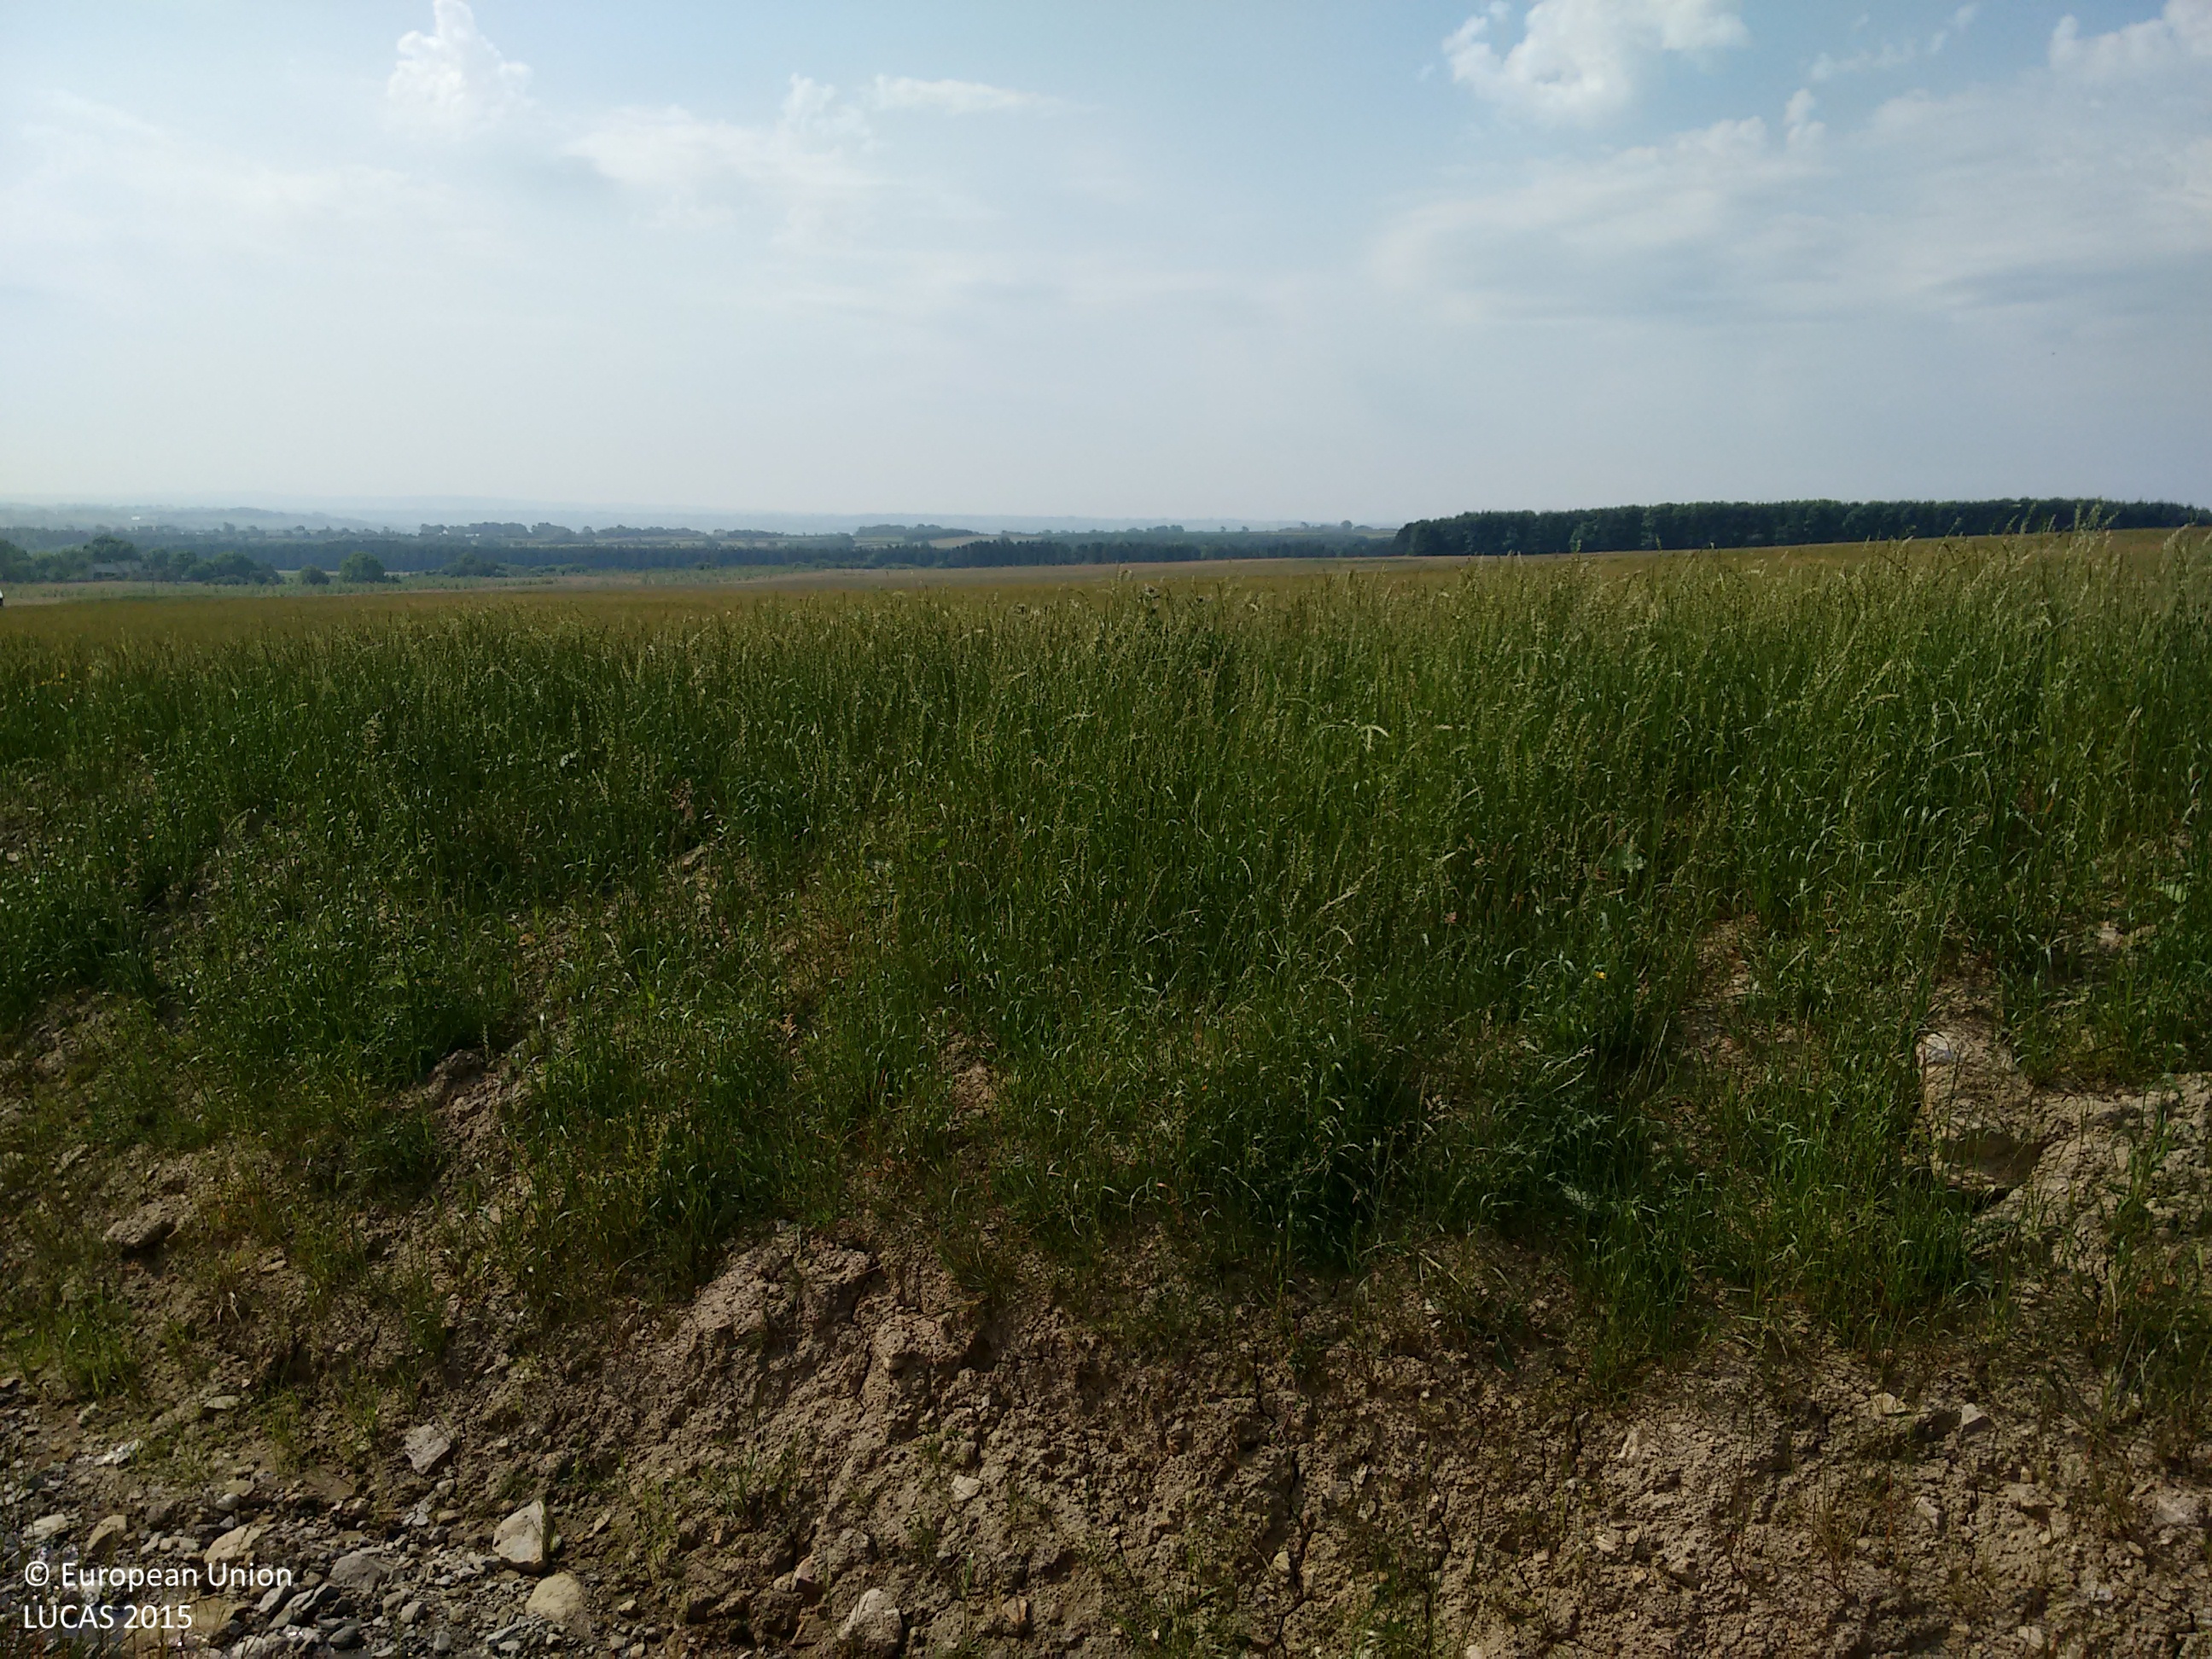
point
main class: Grassland
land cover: Grassland without tree/shrub cover
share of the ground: > 75 %
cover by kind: herbaceous plants 100 %
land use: Agriculture (excluding fallow land and kitchen gardens)
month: July
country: GB
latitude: 54.7338
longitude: -1.7772
